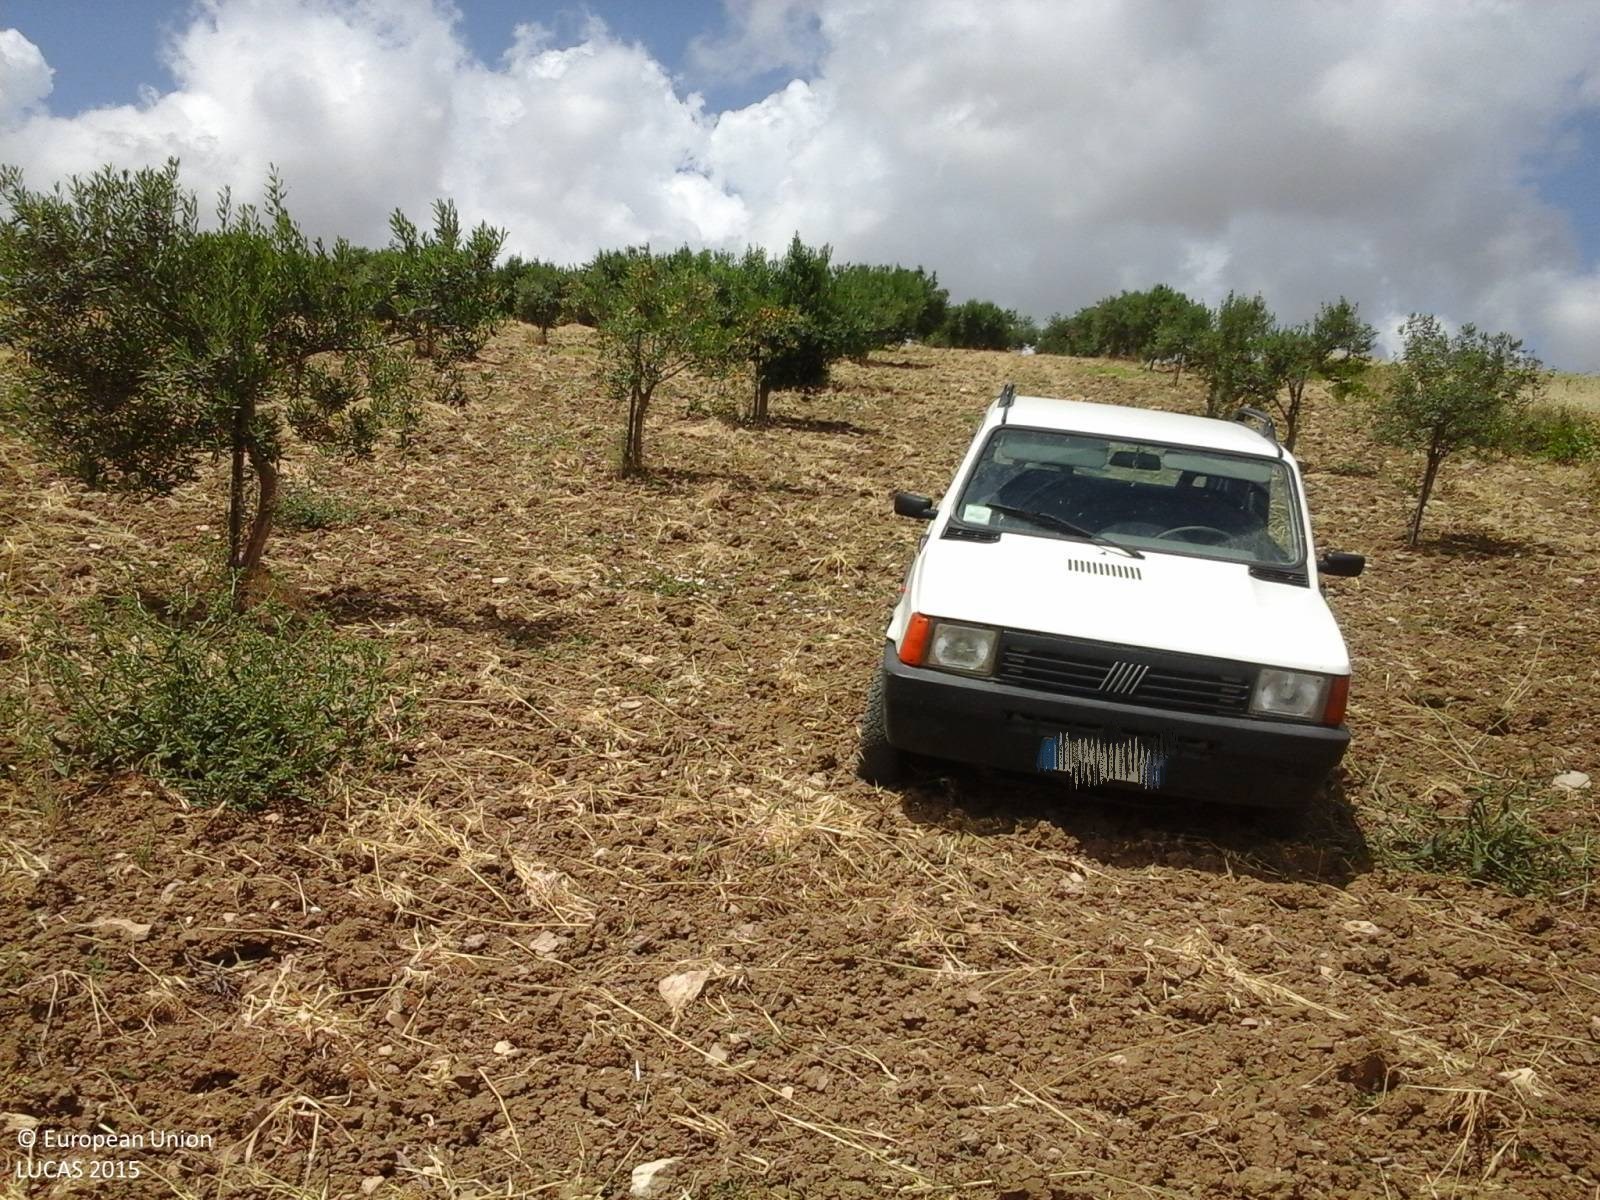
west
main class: Cropland
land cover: Olive groves
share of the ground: 25 - 50 %
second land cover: Other bare soil
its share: > 75 %
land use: Agriculture (excluding fallow land and kitchen gardens)
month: June
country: IT
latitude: 38.0367
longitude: 12.6810
